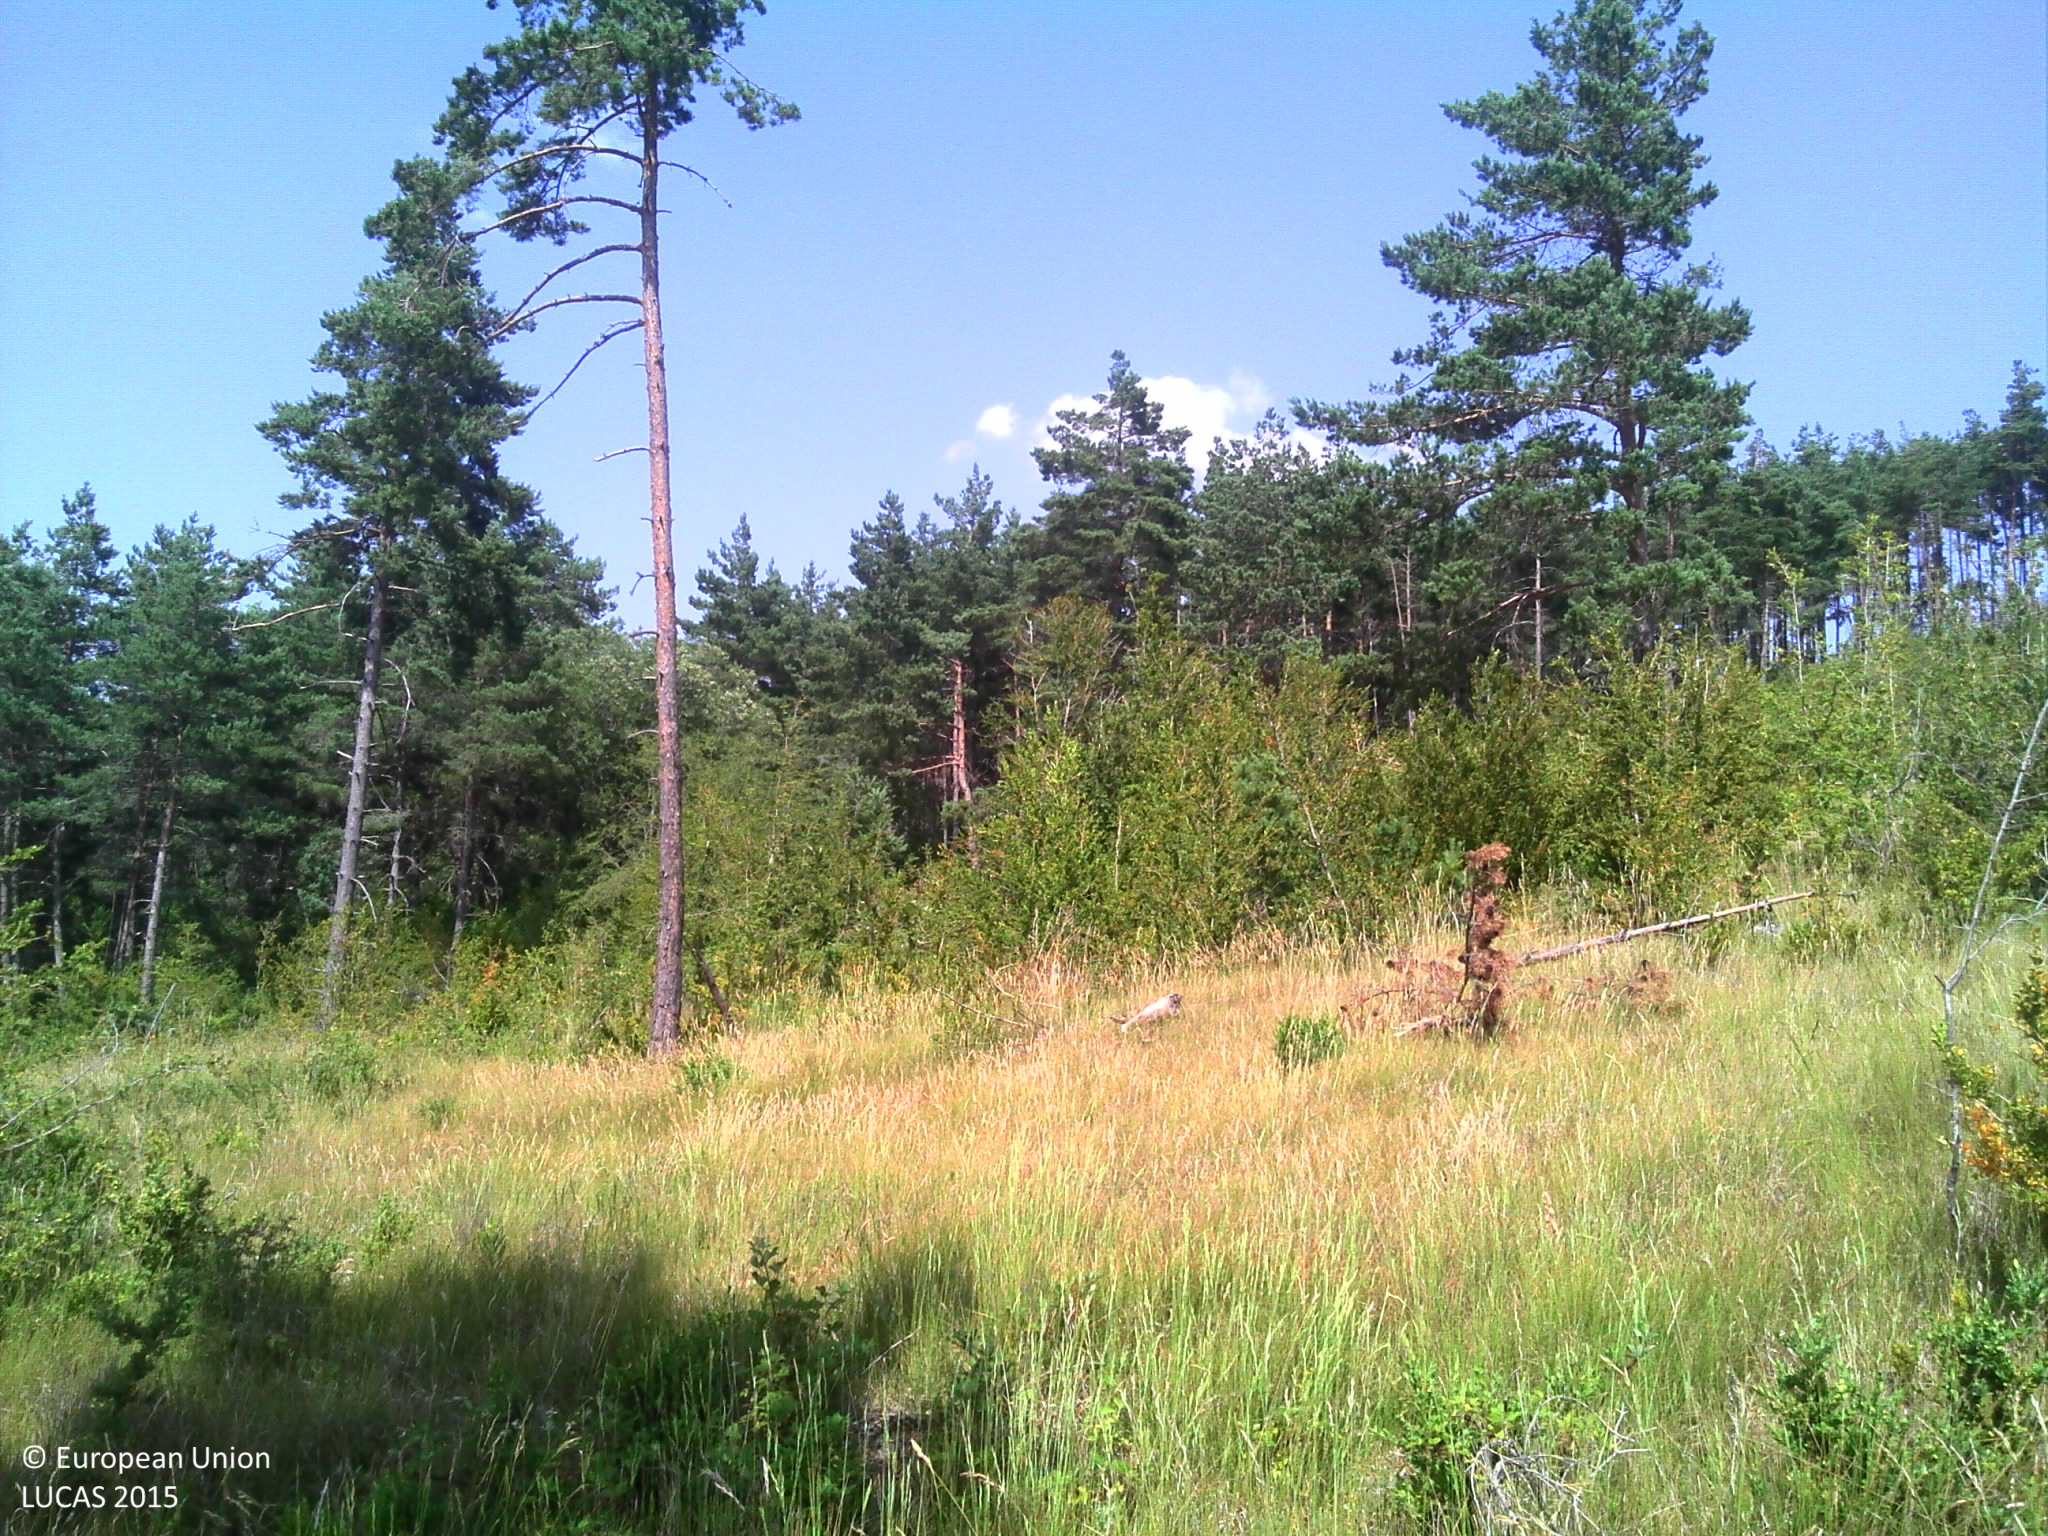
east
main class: Shrubland
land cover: Shrubland with sparse tree cover
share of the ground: > 75 %
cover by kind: shrubs 95 %, coniferous forest trees 5 %
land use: Forestry
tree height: < 5 m
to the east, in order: Shrubland with sparse tree cover; Tracks; Fences; Shrubland with sparse tree cover
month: July
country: FR
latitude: 44.2413
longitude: 3.2816
